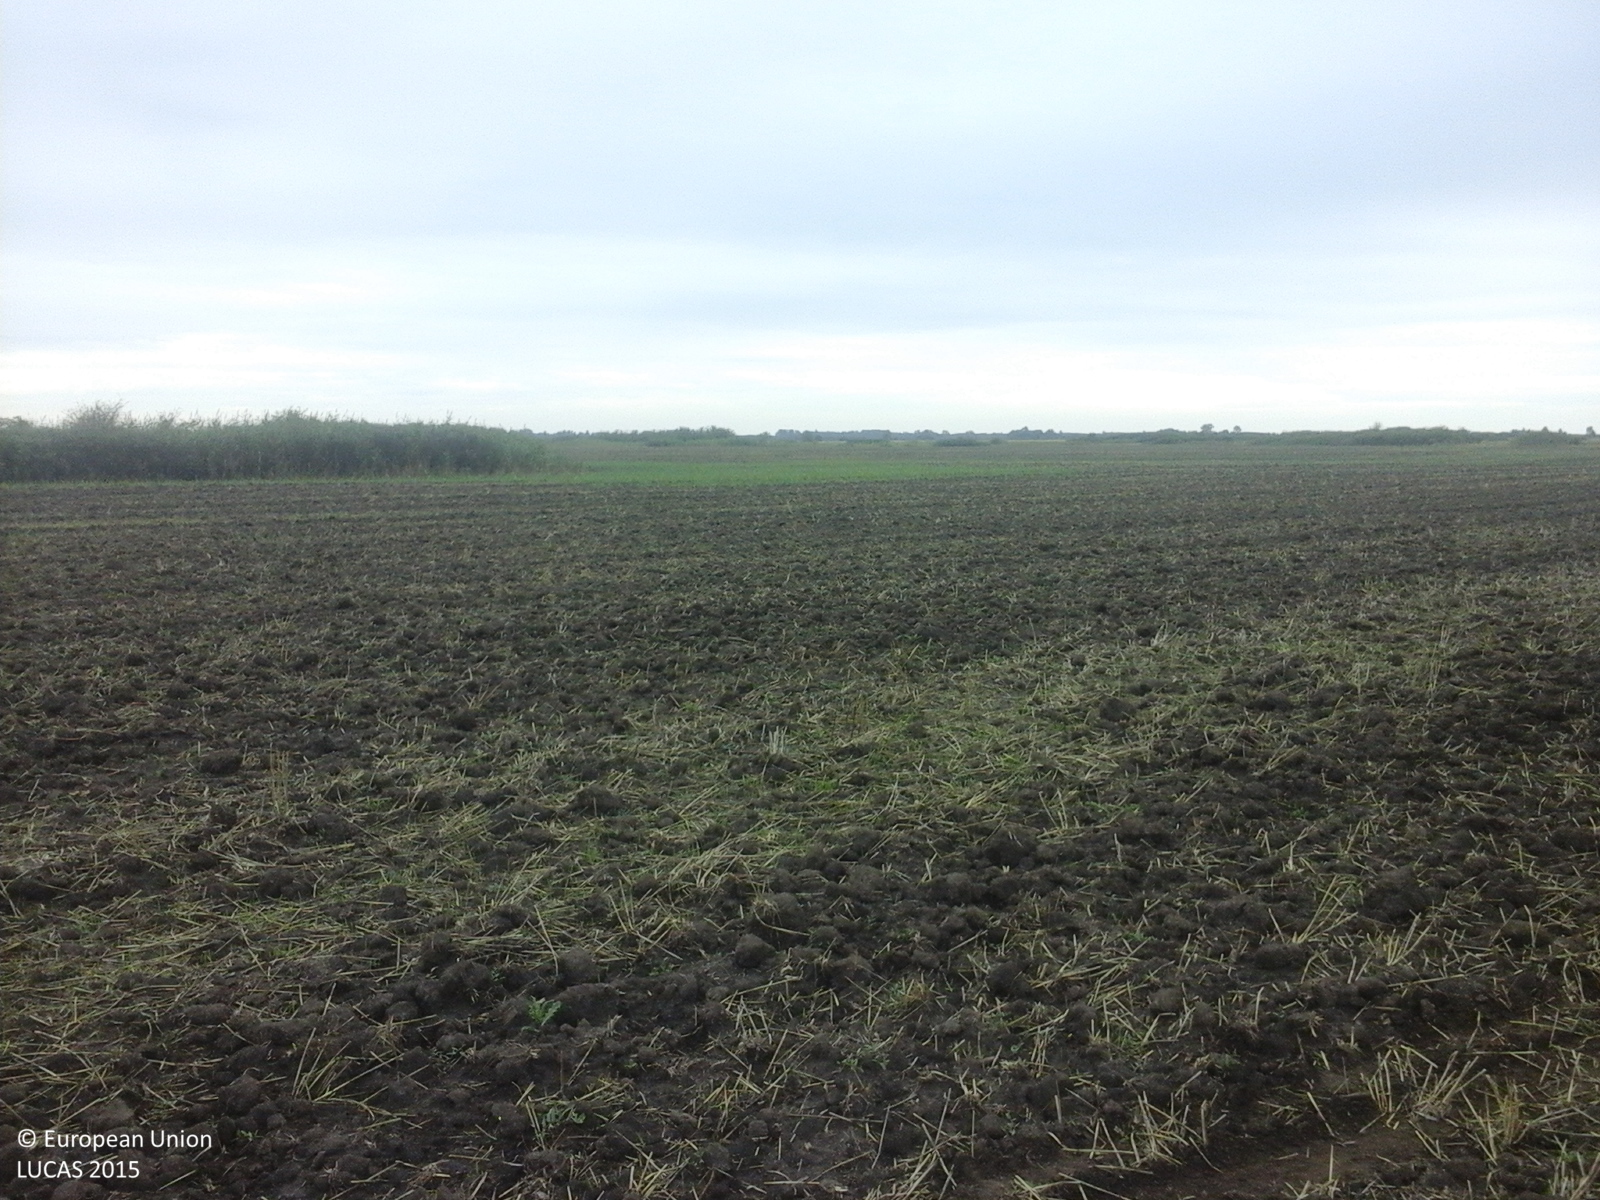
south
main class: Cropland
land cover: Common wheat
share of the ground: < 10 %
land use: Agriculture (excluding fallow land and kitchen gardens)
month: August
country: RO
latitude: 45.3648
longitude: 20.9927
